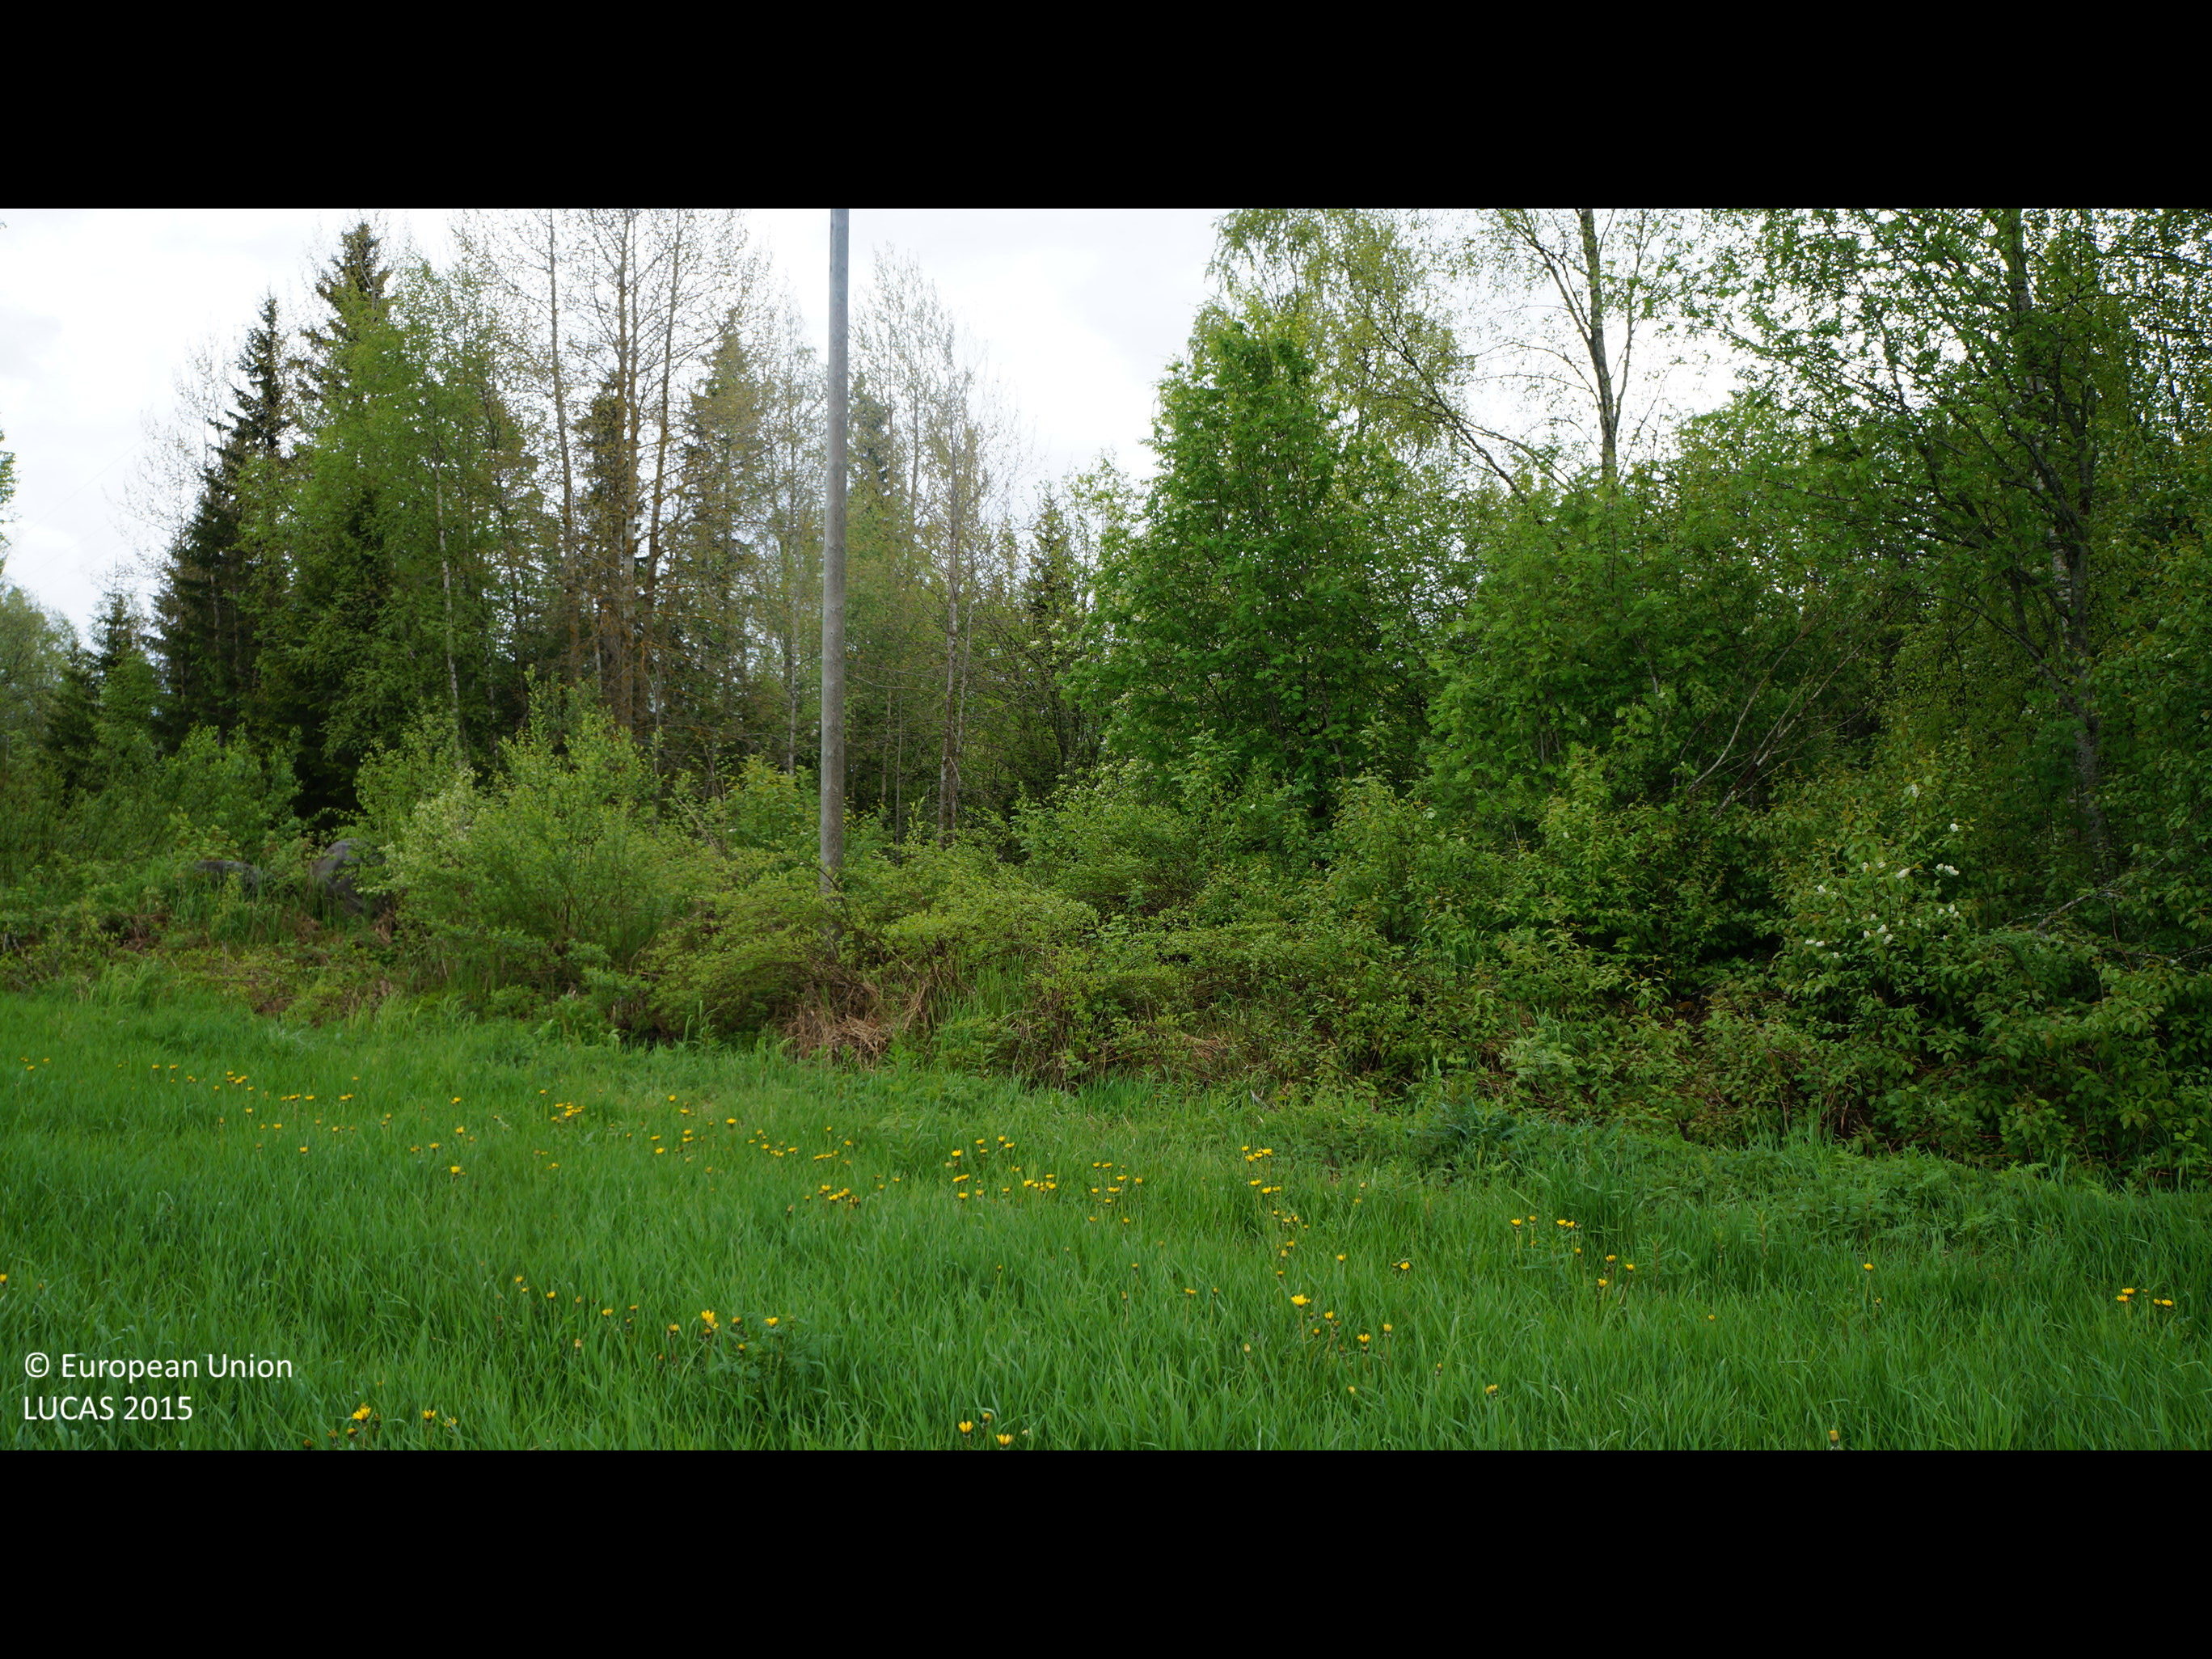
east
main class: Cropland
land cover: Temporary grasslands
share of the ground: > 75 %
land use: Agriculture (excluding fallow land and kitchen gardens)
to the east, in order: Temporary grasslands; Ditches and canals; Broadleaved woodland; Electric lines; Grassland with sparse tree/shrub cover; Broadleaved woodland; Shrubland with sparse tree cover; Spruce dominated mixed woodland; Grassland with sparse tree/shrub cover; Electric lines; Broadleaved woodland; Ditches and canals; Oats; Ditches and canals; Oats; Ditches and canals; Grassland without tree/shrub cover; Ditches and canals; Other mixed woodland
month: June
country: FI
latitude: 63.8119
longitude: 23.3594
